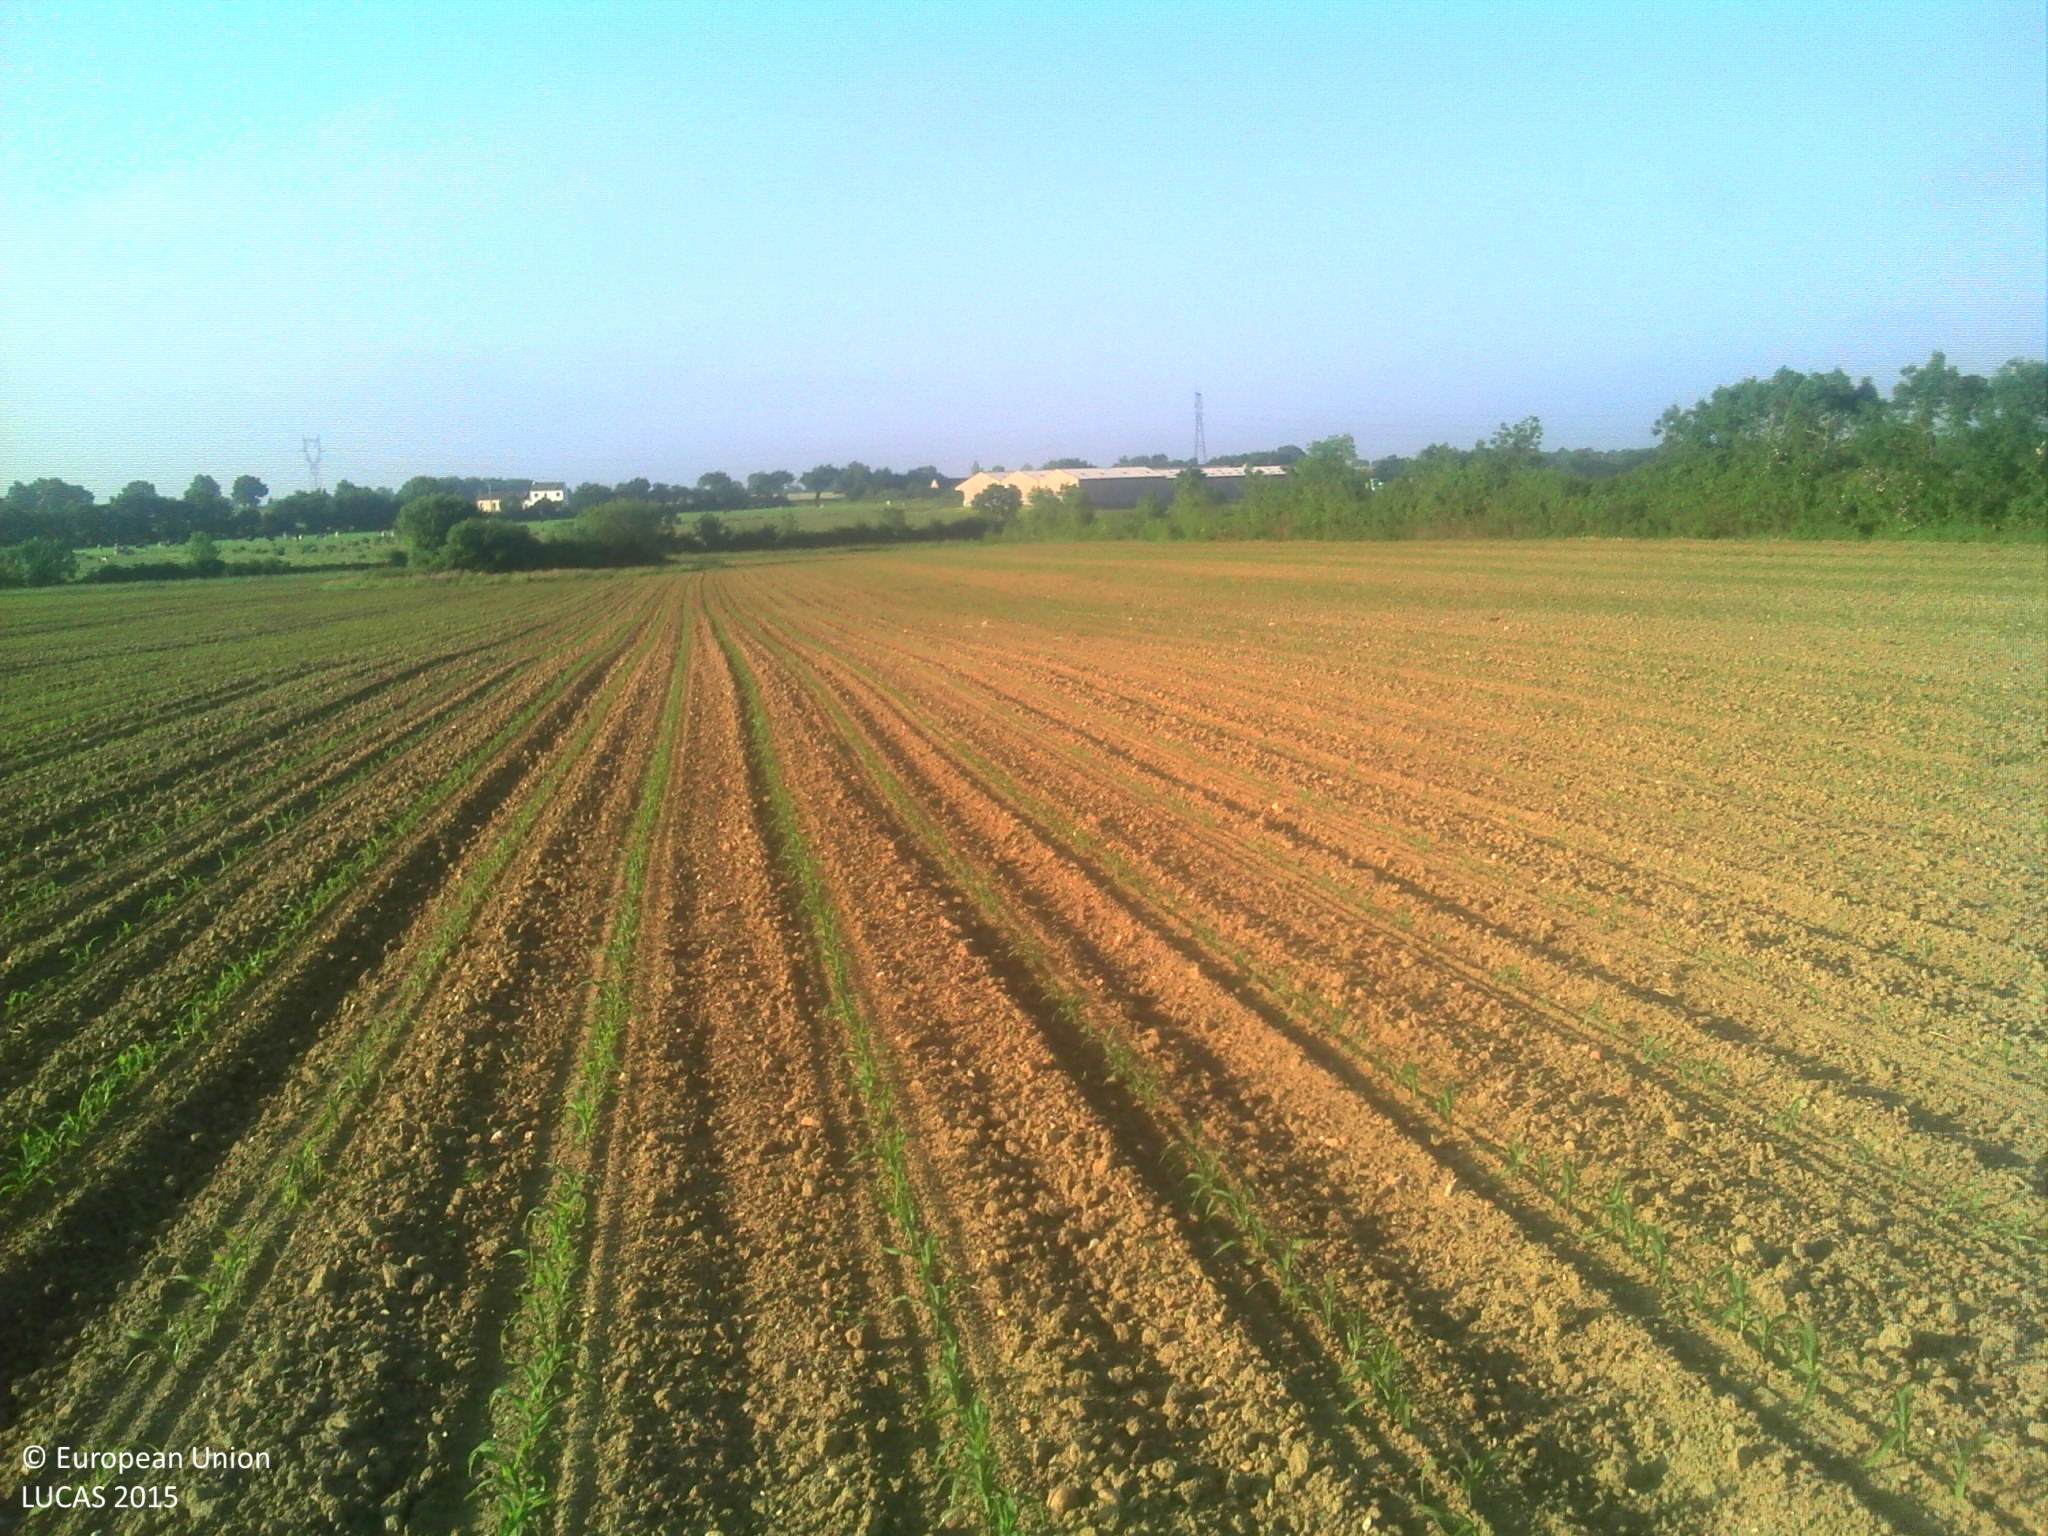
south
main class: Cropland
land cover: Maize
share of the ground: 25 - 50 %
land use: Agriculture (excluding fallow land and kitchen gardens)
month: May
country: FR
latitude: 47.4324
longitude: -1.0277
